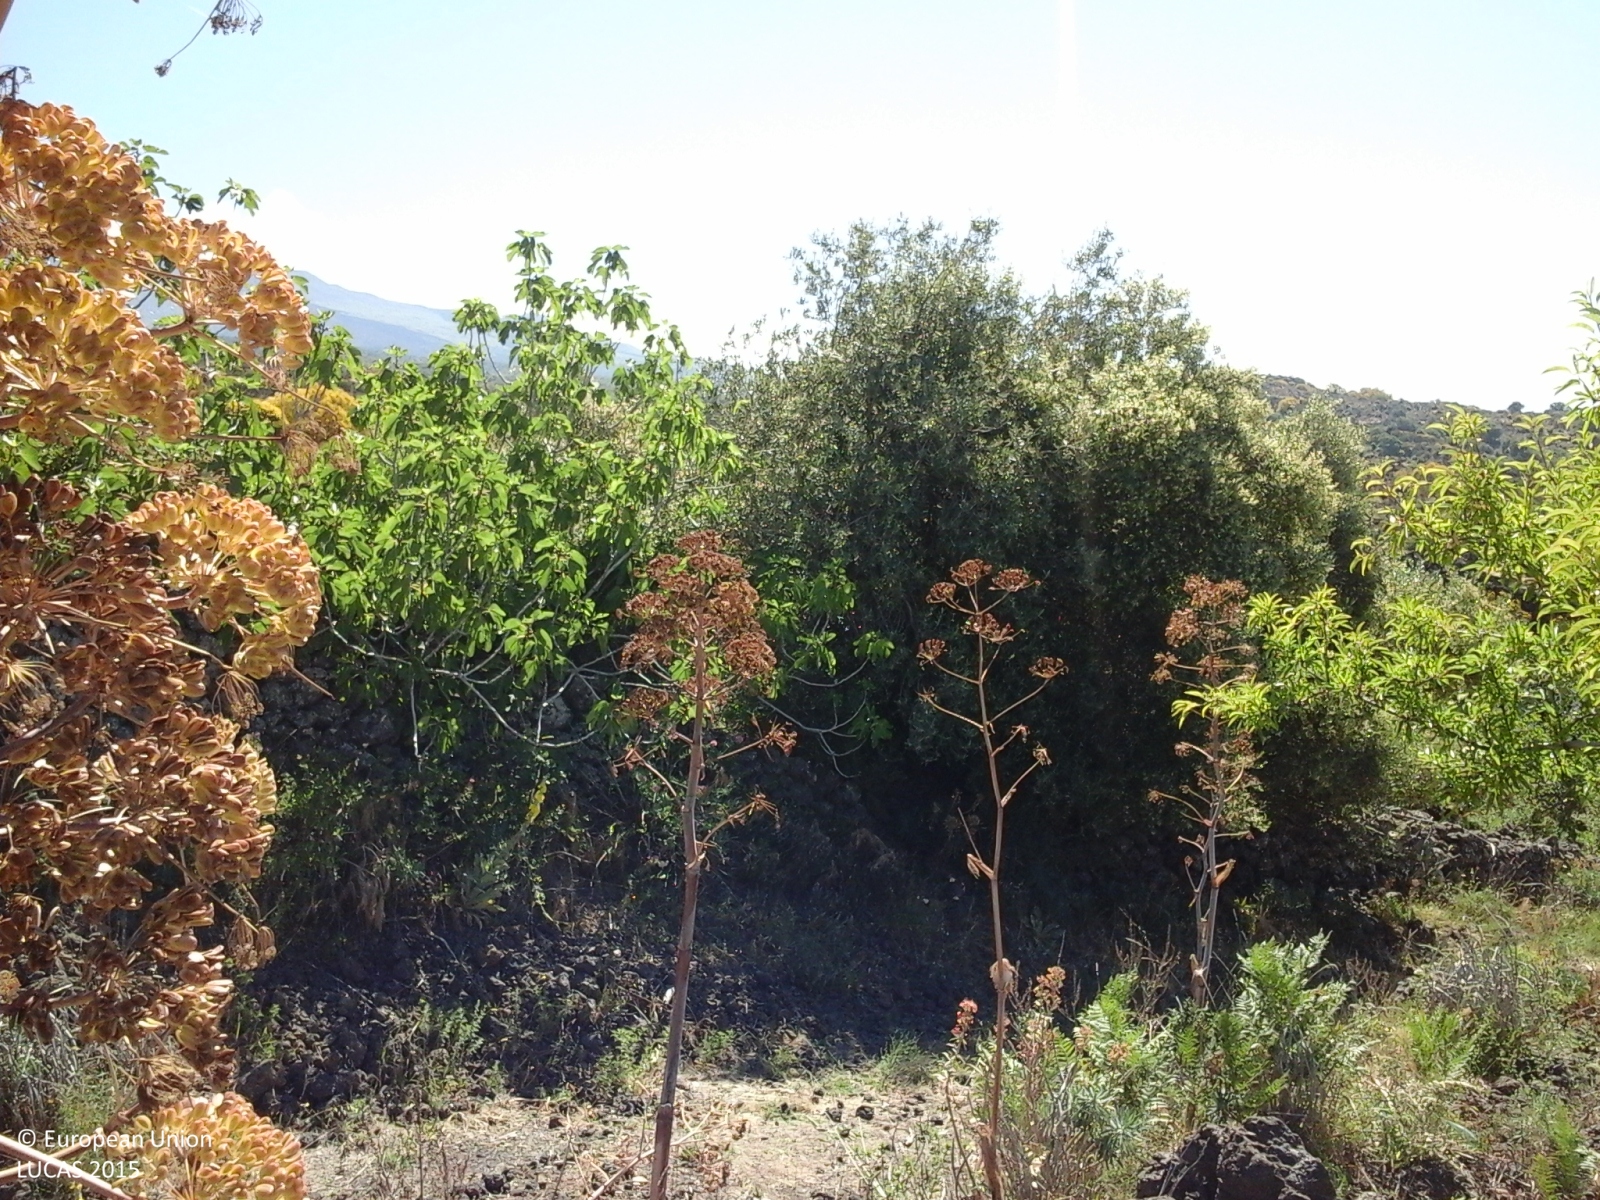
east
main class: Shrubland
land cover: Shrubland with sparse tree cover
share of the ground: > 75 %
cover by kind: shrubs 95 %, broadleaved forest trees 5 %
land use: Amenities, museums, leisure
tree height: < 5 m
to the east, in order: Shrubland with sparse tree cover; Rocks and stones; Broadleaved woodland
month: June
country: IT
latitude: 37.6951
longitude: 14.8764
